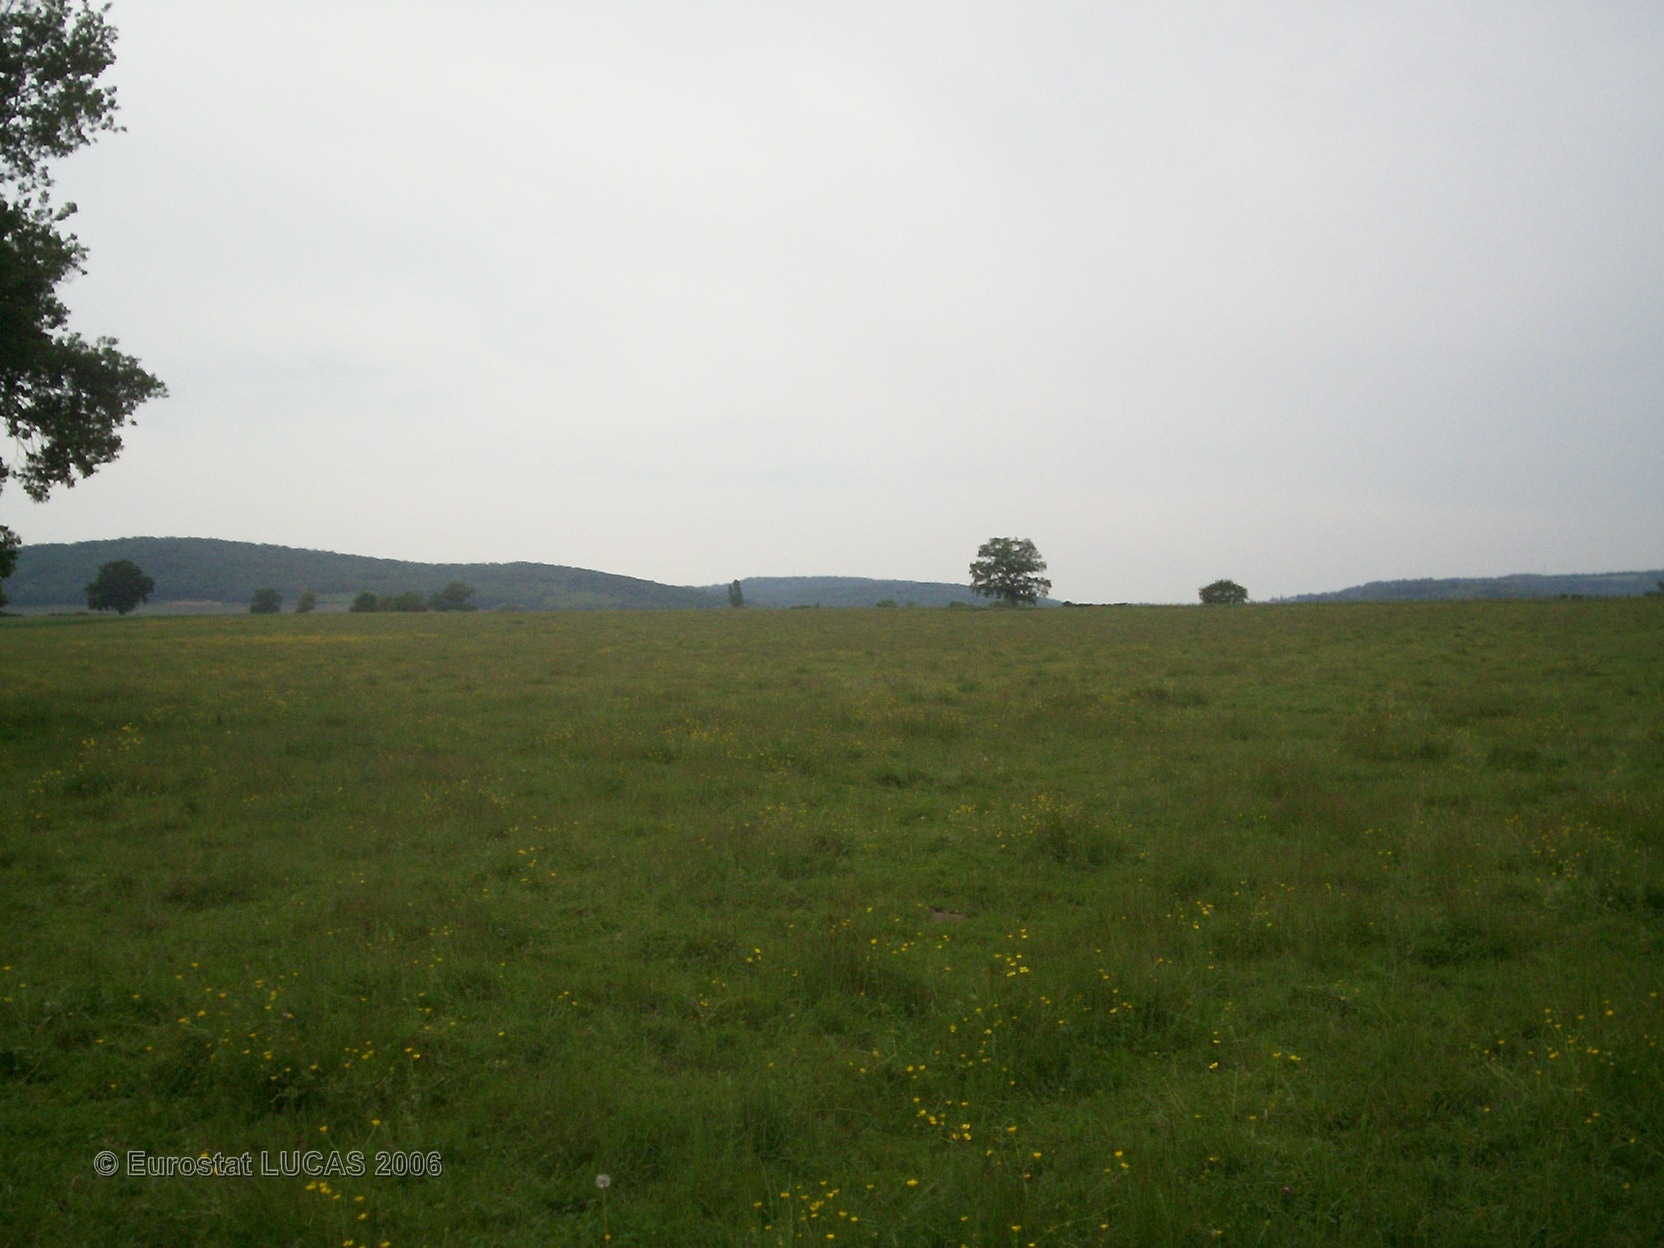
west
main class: Grassland
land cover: Grassland with sparse tree/shrub cover
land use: Agriculture (excluding fallow land and kitchen gardens)
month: May
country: FR
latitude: 46.6355
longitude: 4.7110
